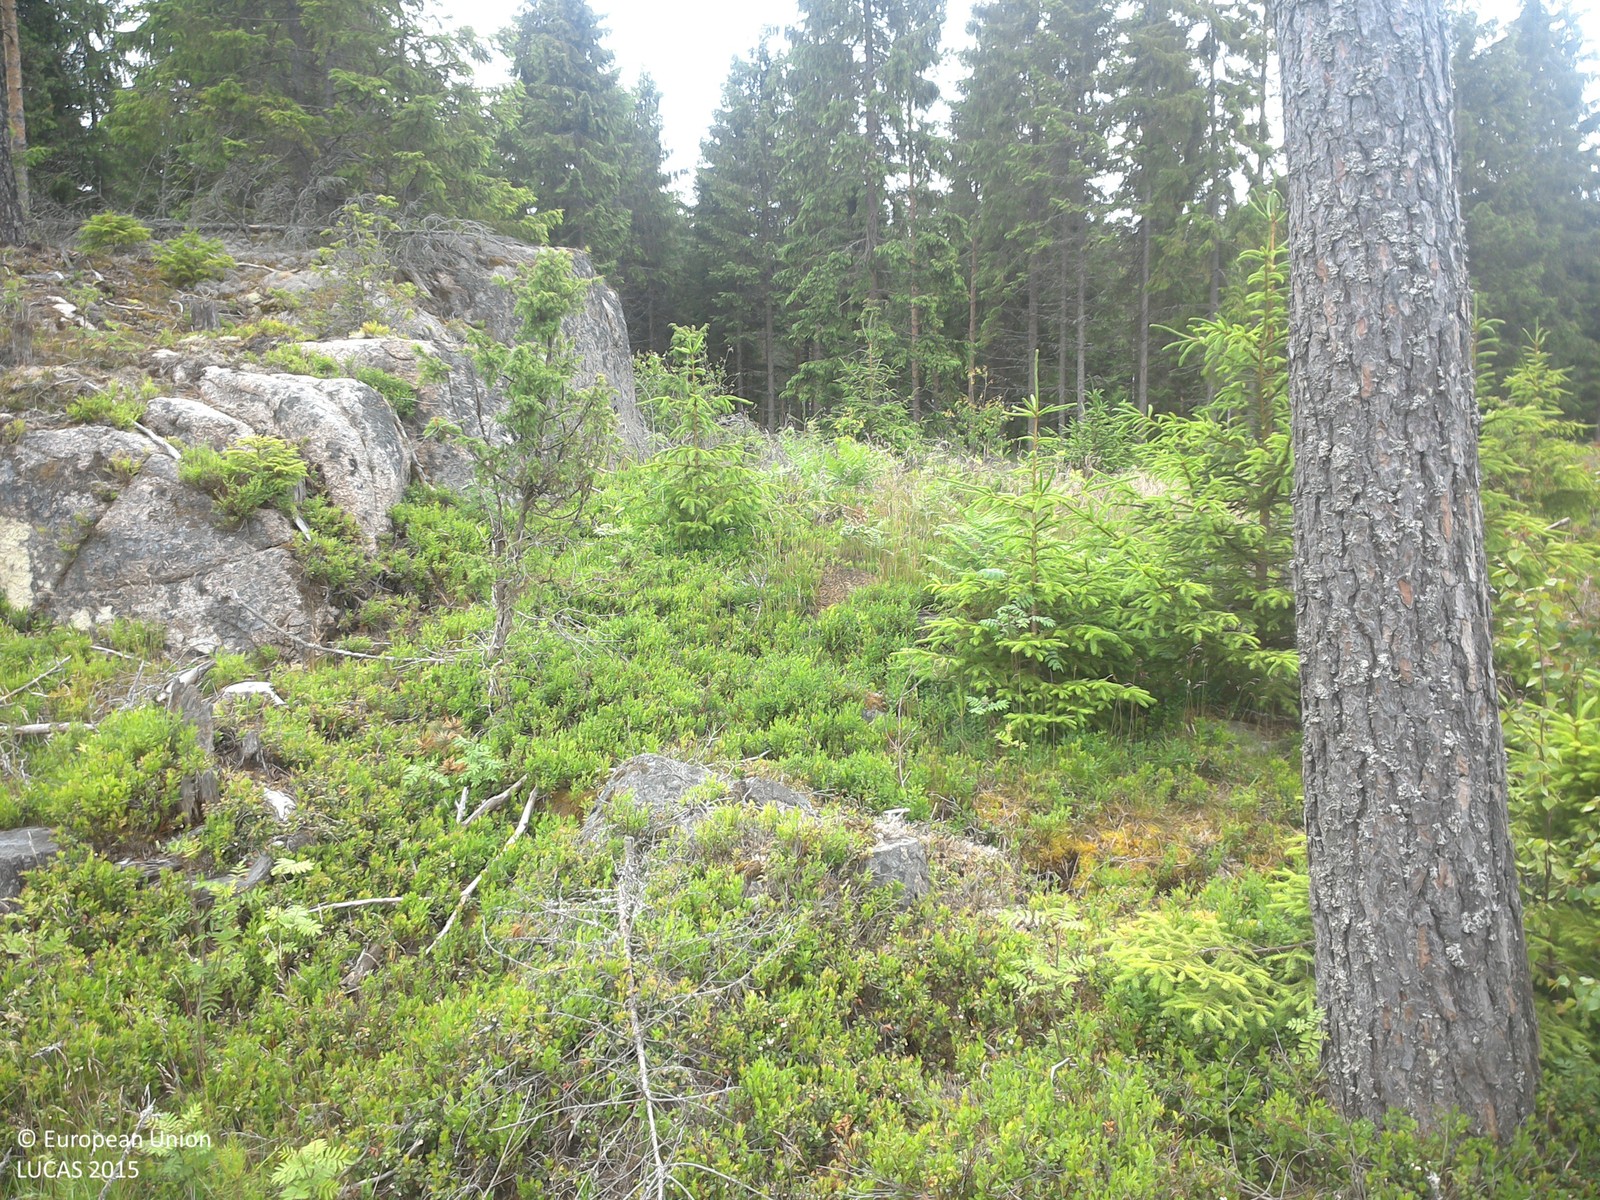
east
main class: Woodland
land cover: Pine dominated coniferous woodland
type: boreal forest
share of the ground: 10 - 25 %
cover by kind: herbaceous plants 45 %, lichens and mosses 40 %, coniferous forest trees 15 %
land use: Forestry
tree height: > 5 m
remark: Clear cut
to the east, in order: Pine dominated coniferous woodland; Spruce dominated coniferous woodland; Lichens and moss; Spruce dominated coniferous woodland; Pine dominated coniferous woodland; Grassland without tree/shrub cover; Tracks; Broadleaved woodland
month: June
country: SE
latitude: 58.1452
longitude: 15.4482
